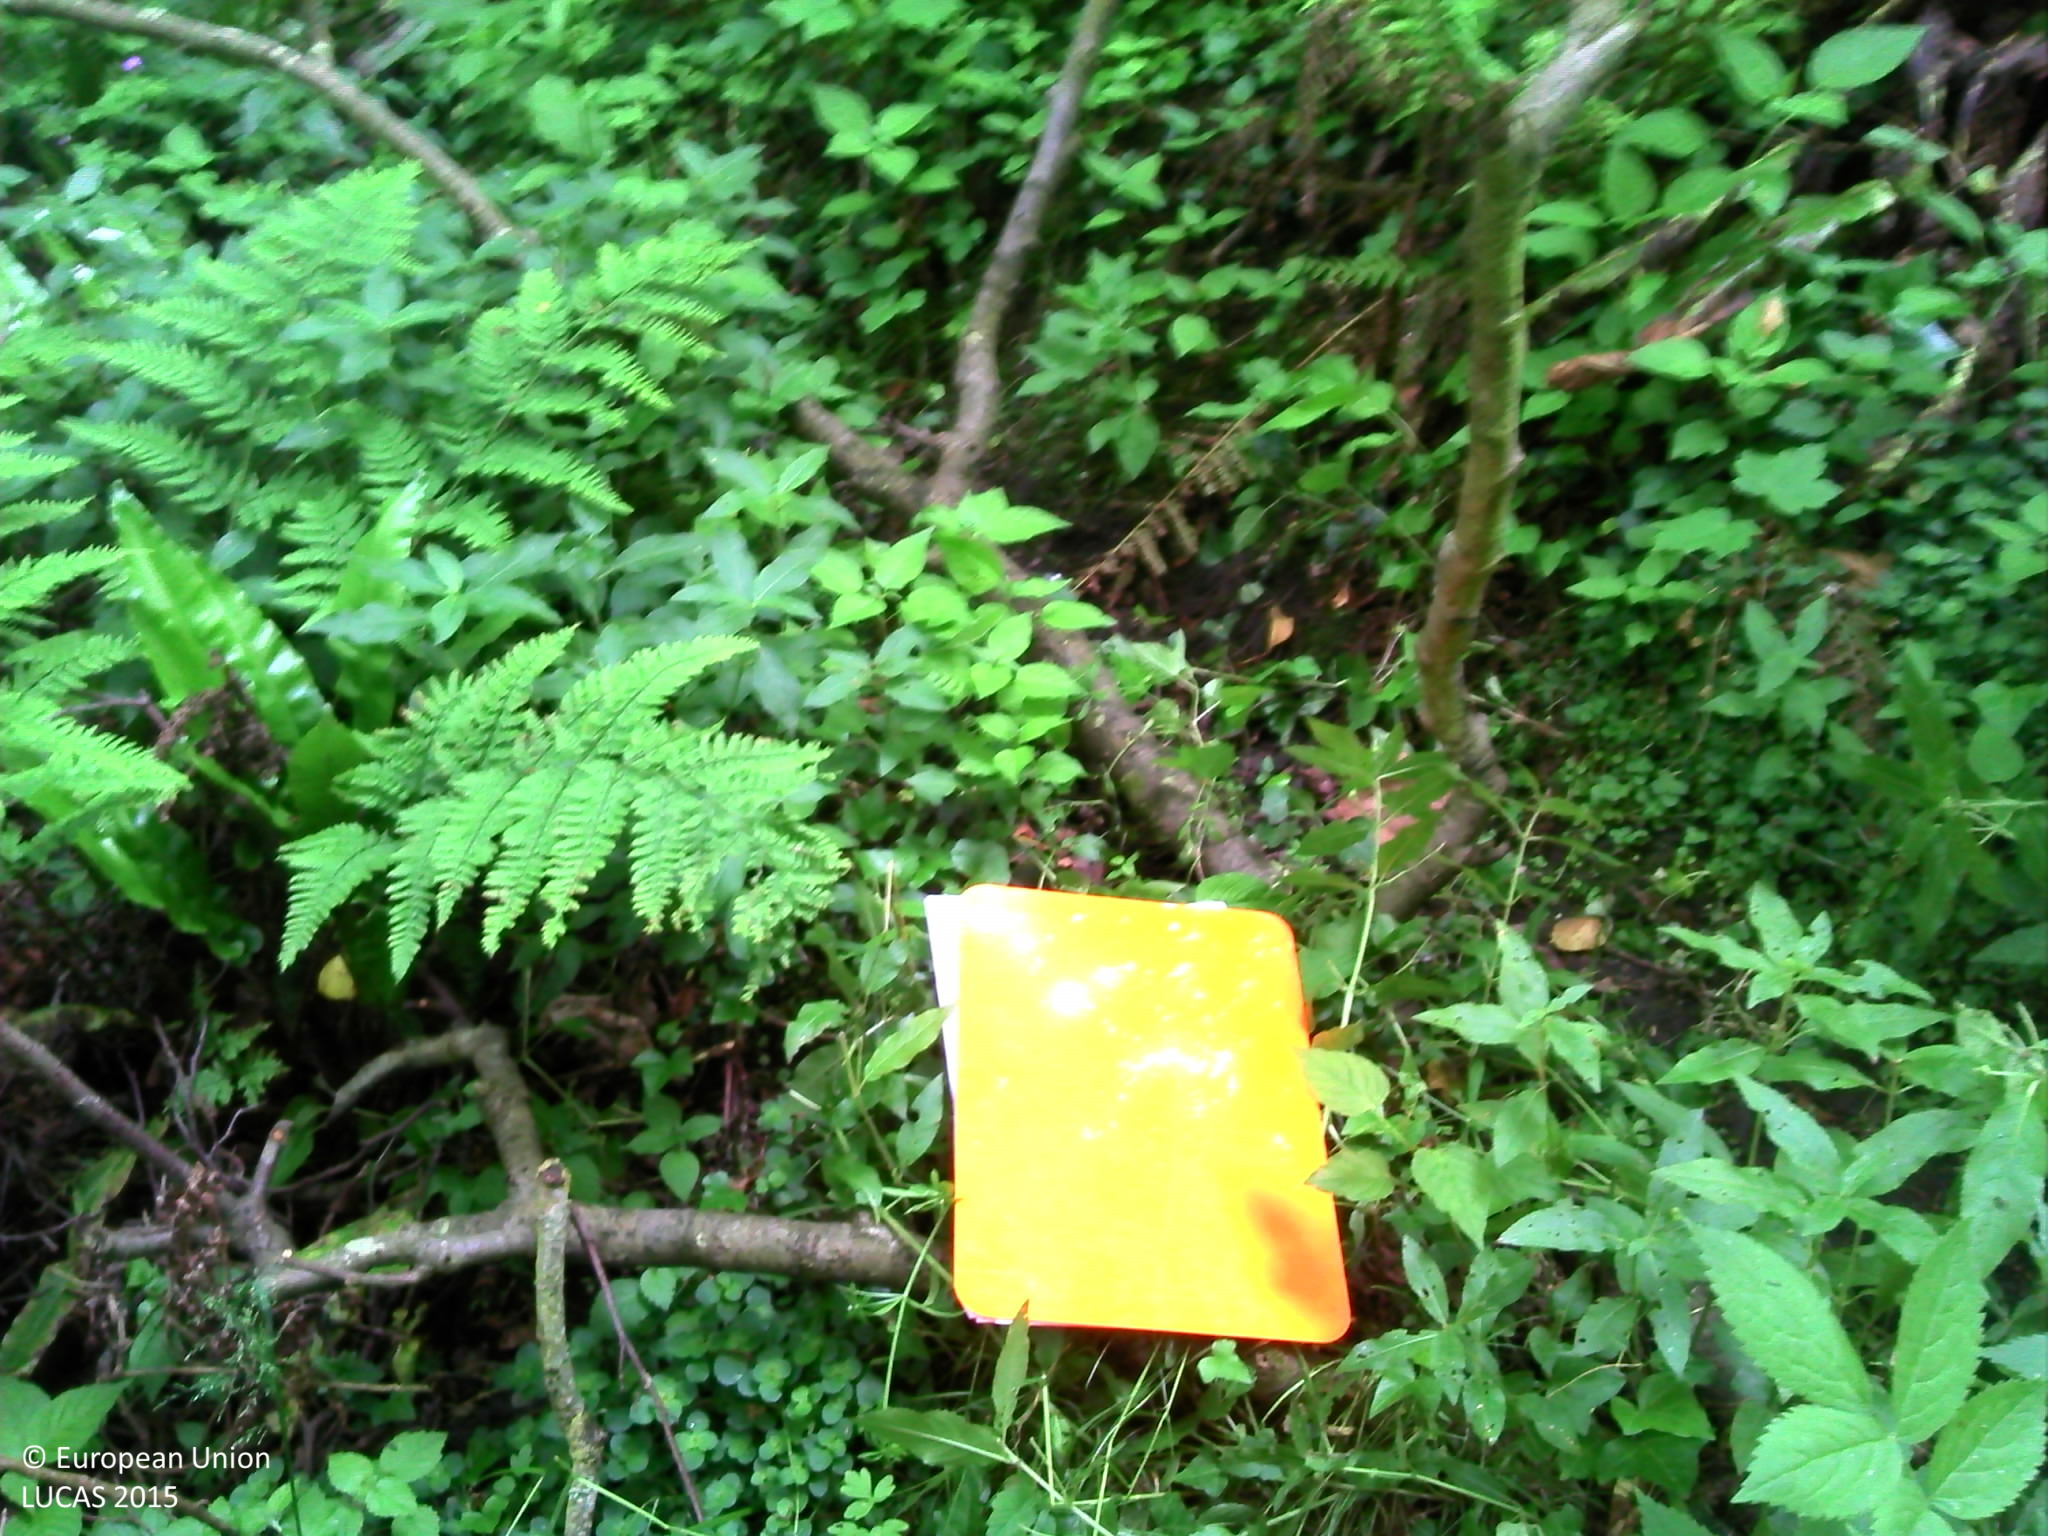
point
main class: Woodland
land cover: Broadleaved woodland
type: mesophytic deciduous forest
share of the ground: > 75 %
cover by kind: broadleaved forest trees 80 %, shrubs 15 %, herbaceous plants 5 %
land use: Semi-natural and natural areas not in use
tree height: > 5 m
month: May
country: FR
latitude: 49.2856
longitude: -0.0539
